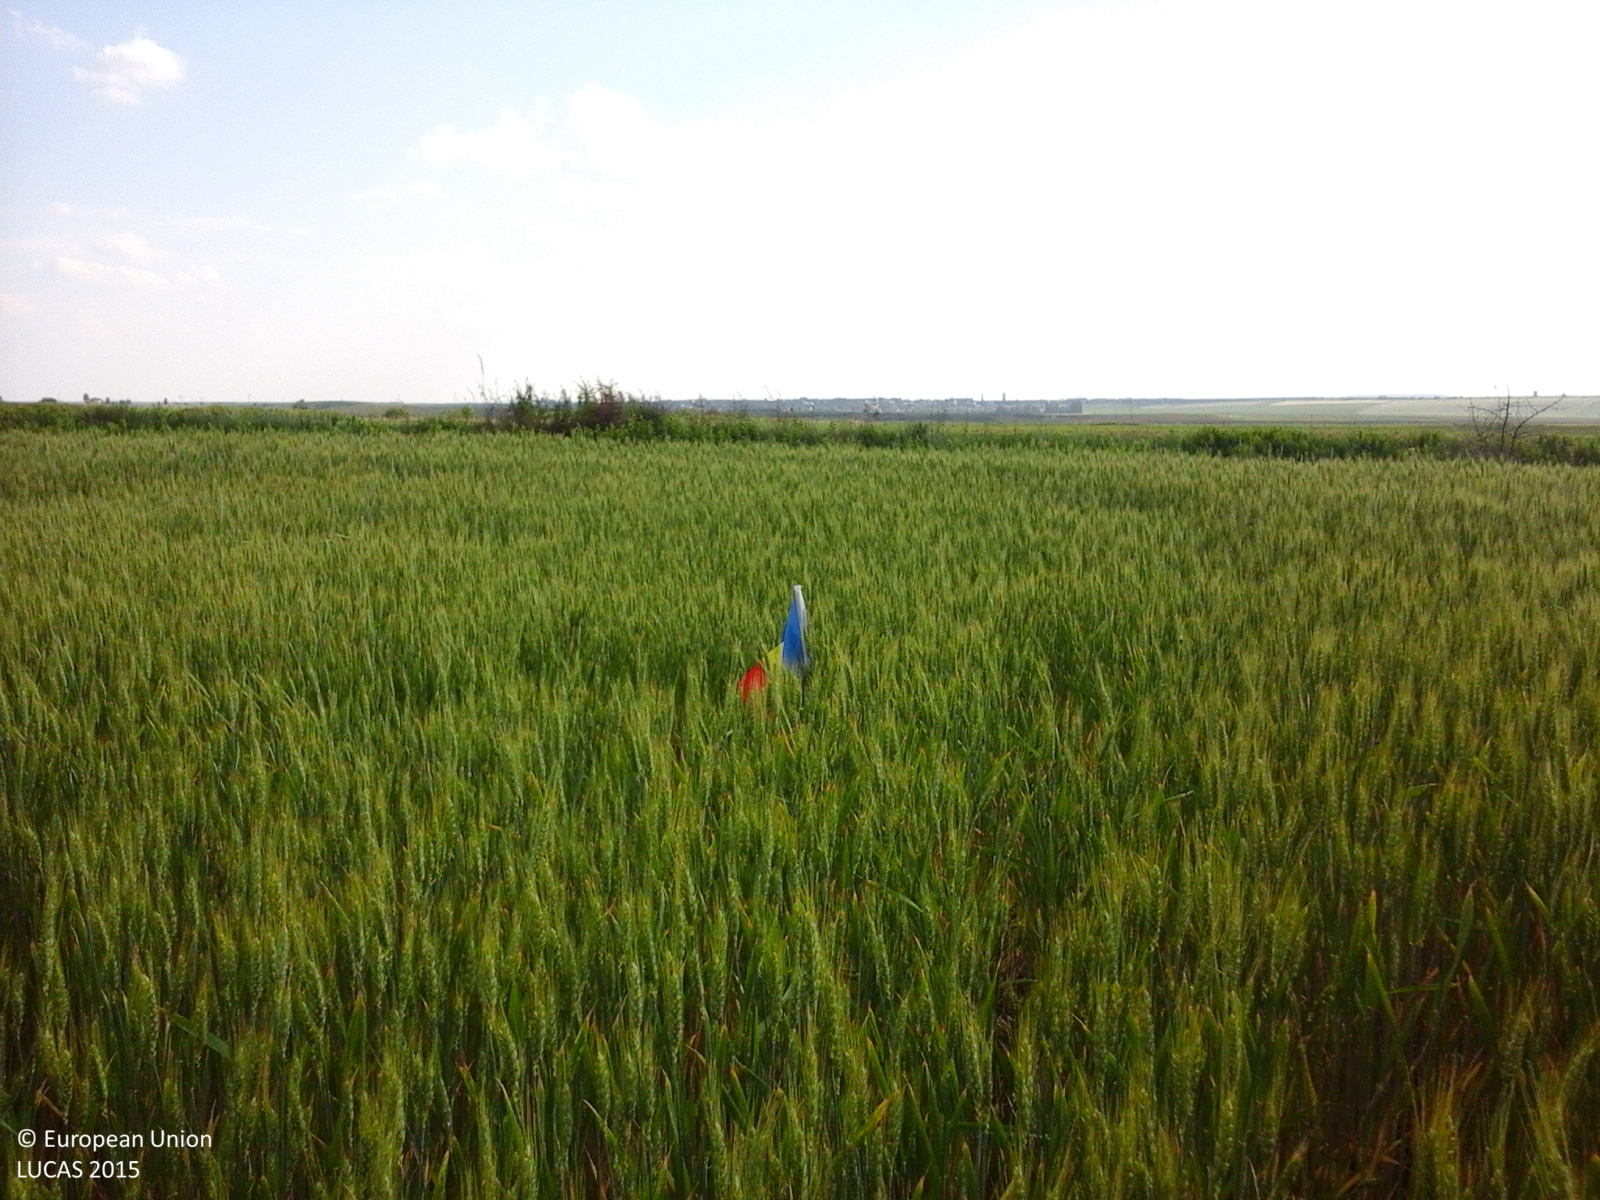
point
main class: Cropland
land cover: Durum wheat
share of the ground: > 75 %
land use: Agriculture (excluding fallow land and kitchen gardens)
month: June
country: RO
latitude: 47.0950
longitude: 26.8676
